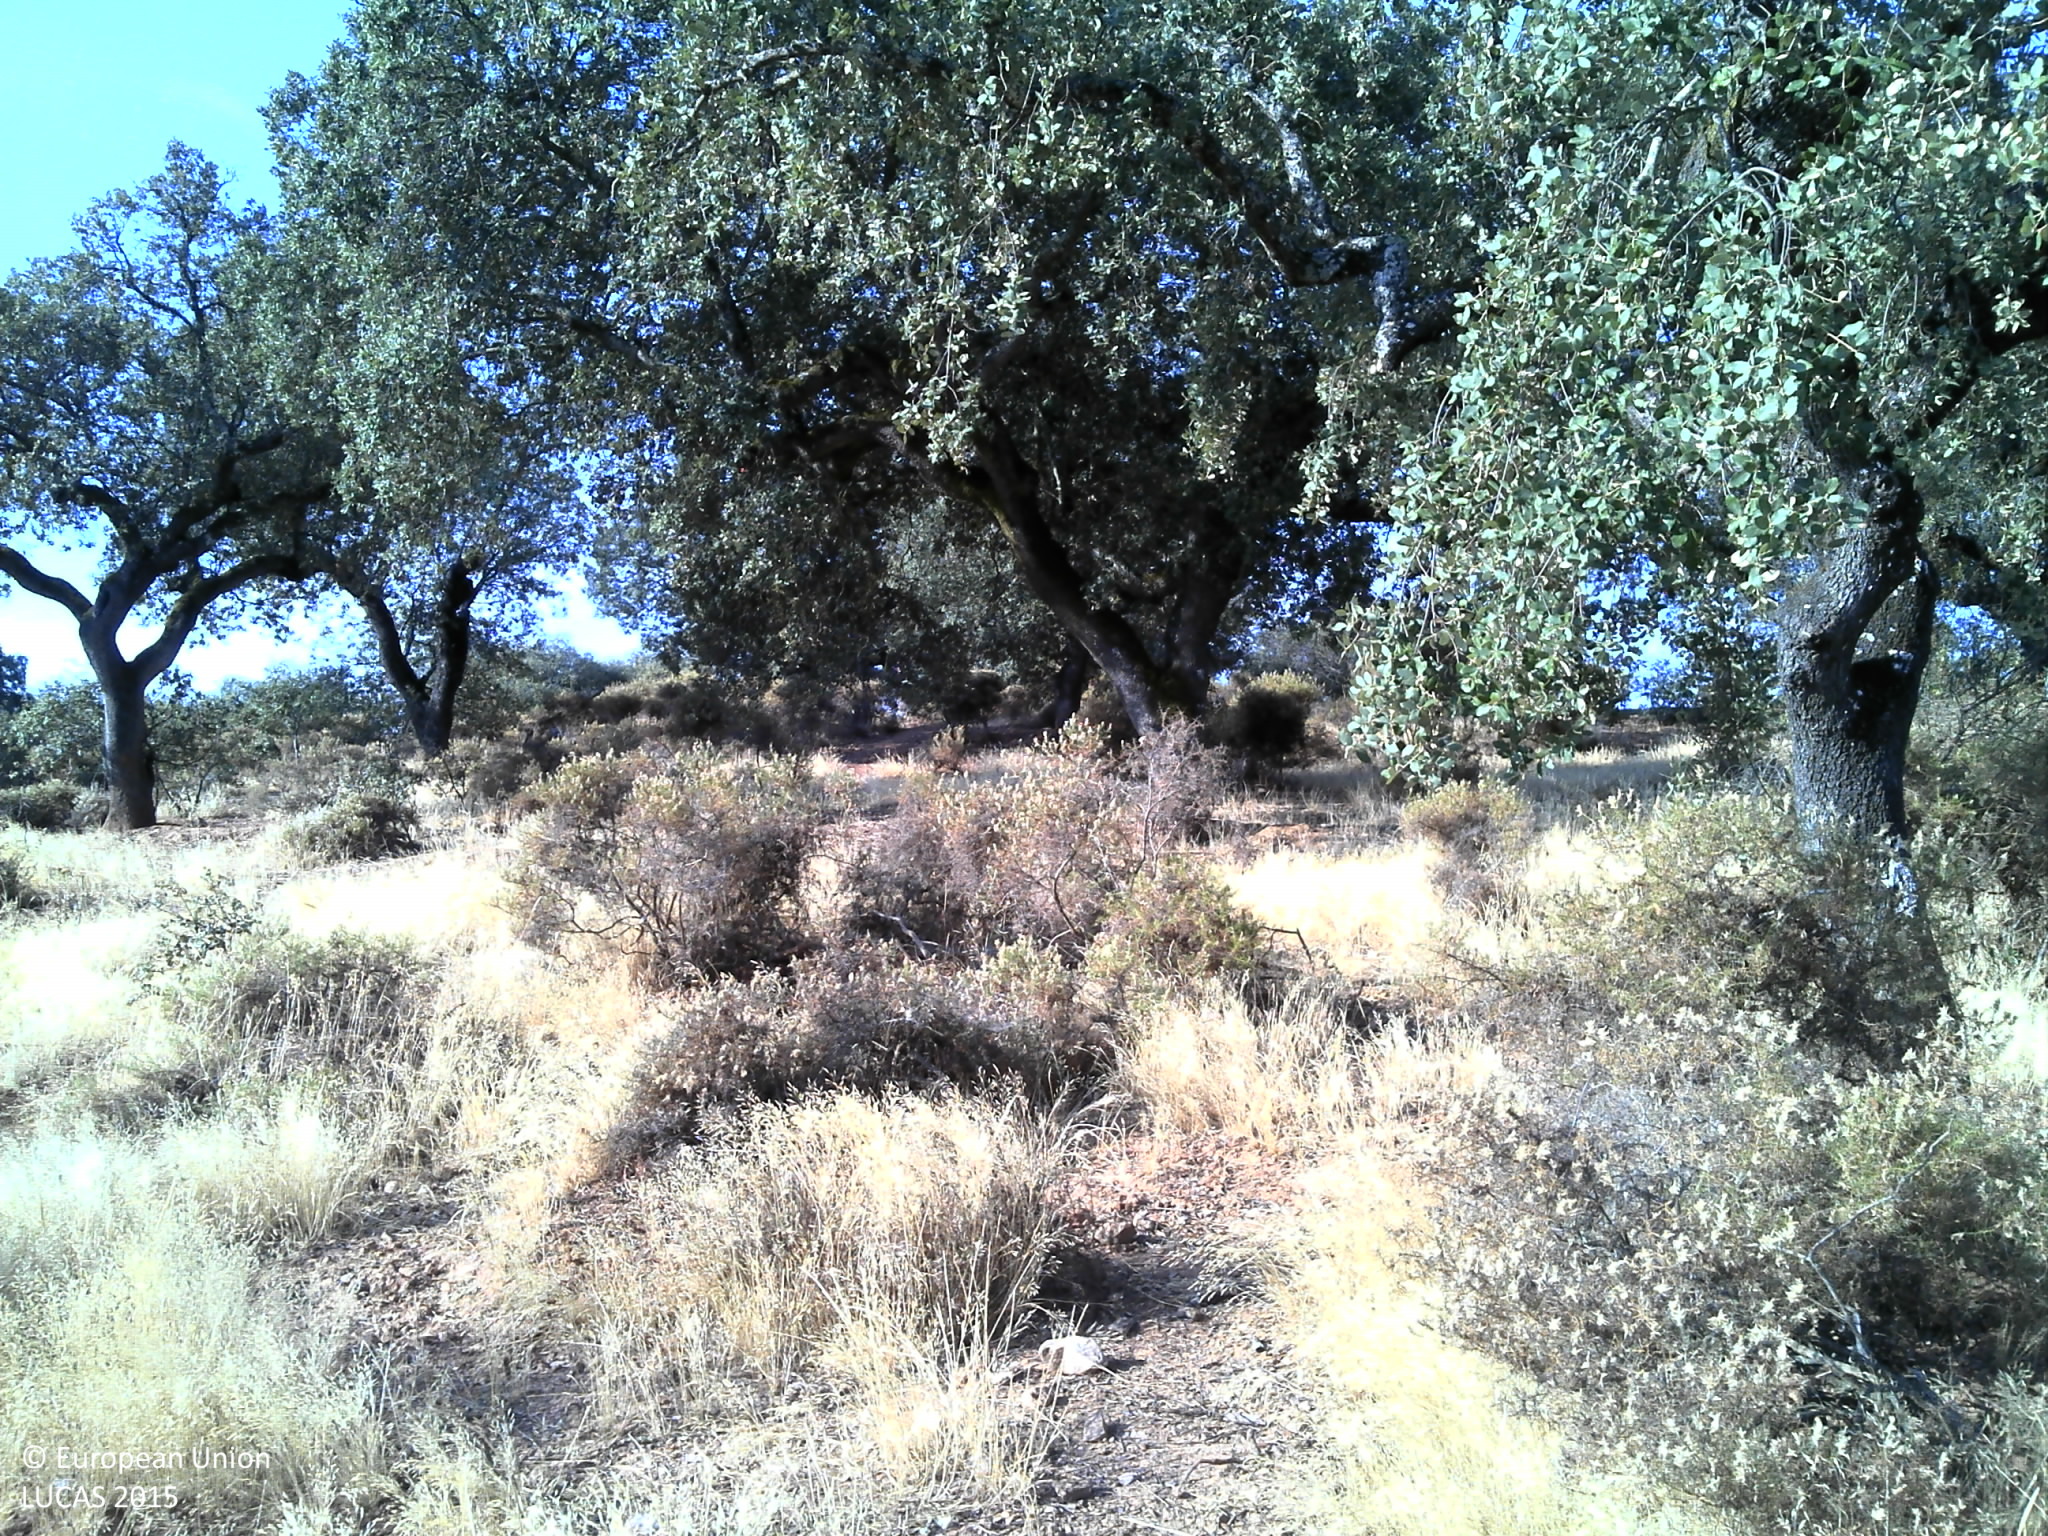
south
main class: Woodland
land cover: Broadleaved woodland
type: broadleaved evergreen forest
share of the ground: 10 - 25 %
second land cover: Shrubland without tree cover
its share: 25 - 50 %
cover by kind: shrubs 30 %, herbaceous plants 30 %, broadleaved forest trees 25 %, unconsolidated bare surface 15 %
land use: Forestry
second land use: Agriculture (excluding fallow land and kitchen gardens)
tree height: > 5 m
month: July
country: PT
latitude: 38.6062
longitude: -7.4025
